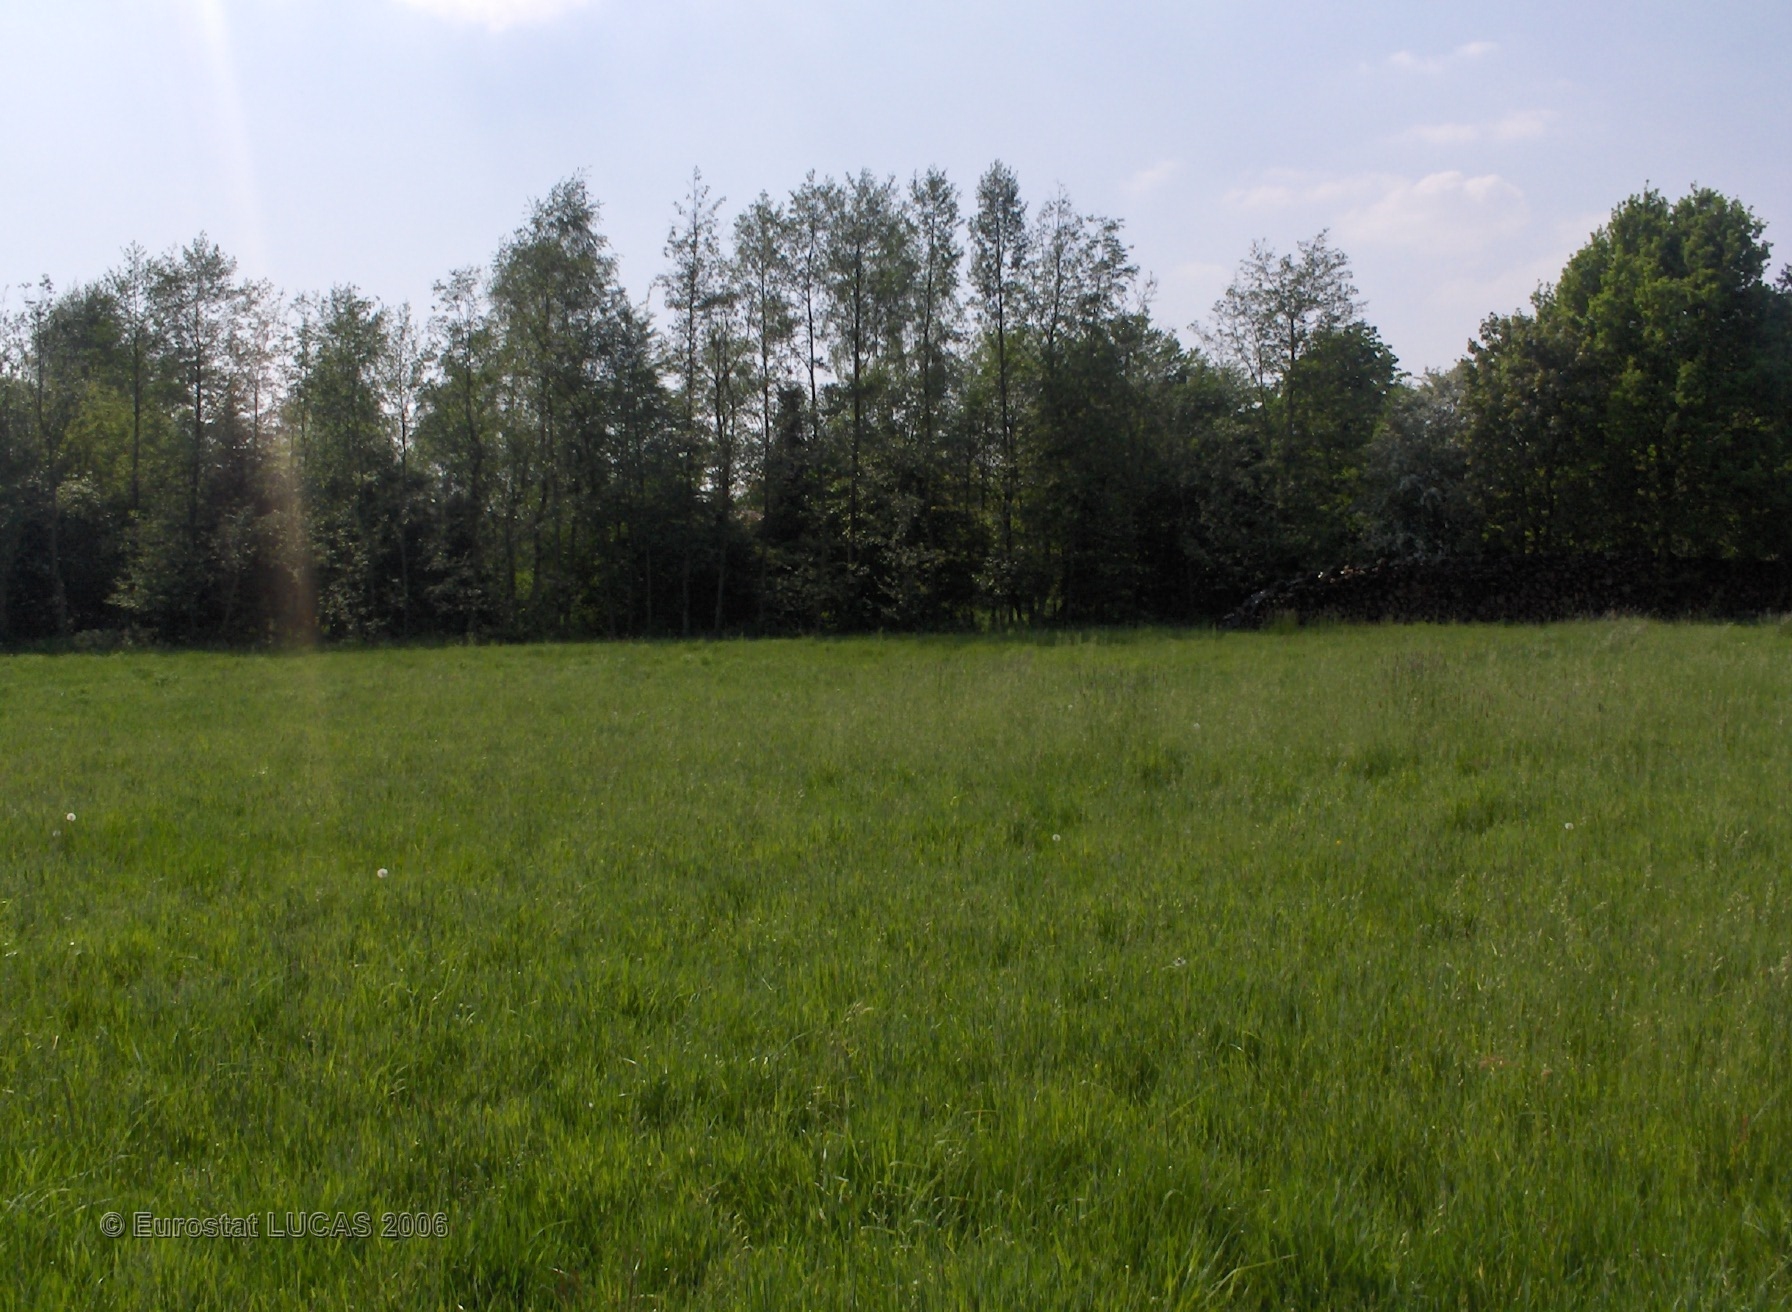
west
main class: Grassland
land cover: Grassland without tree/shrub cover
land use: Agriculture (excluding fallow land and kitchen gardens)
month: May
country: BE
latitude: 51.2515
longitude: 5.1404
